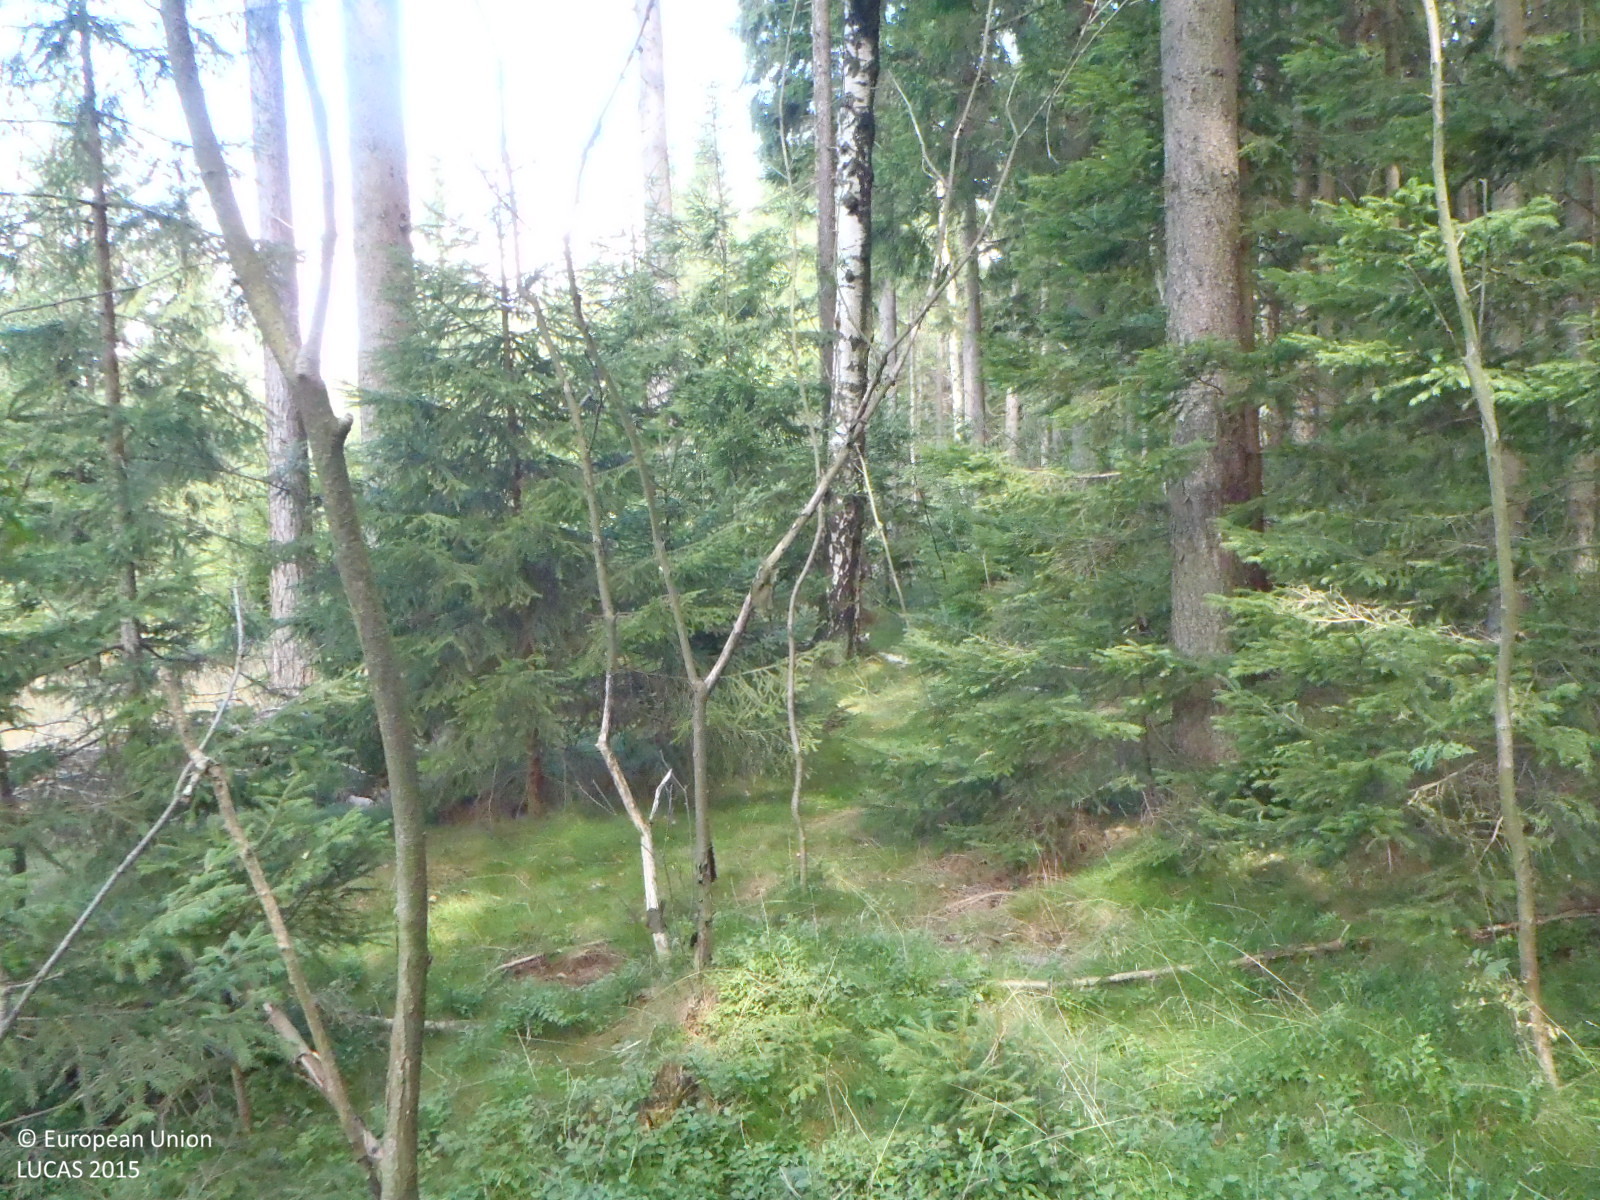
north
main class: Woodland
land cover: Spruce dominated mixed woodland
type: hemiboreal forest and nemoral coniferous forest and mixed broadleaved-coniferous forest
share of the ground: > 75 %
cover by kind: coniferous forest trees 65 %, broadleaved forest trees 30 %, shrubs 5 %
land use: Forestry
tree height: > 5 m
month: August
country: CZ
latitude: 50.9044
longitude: 14.5382
